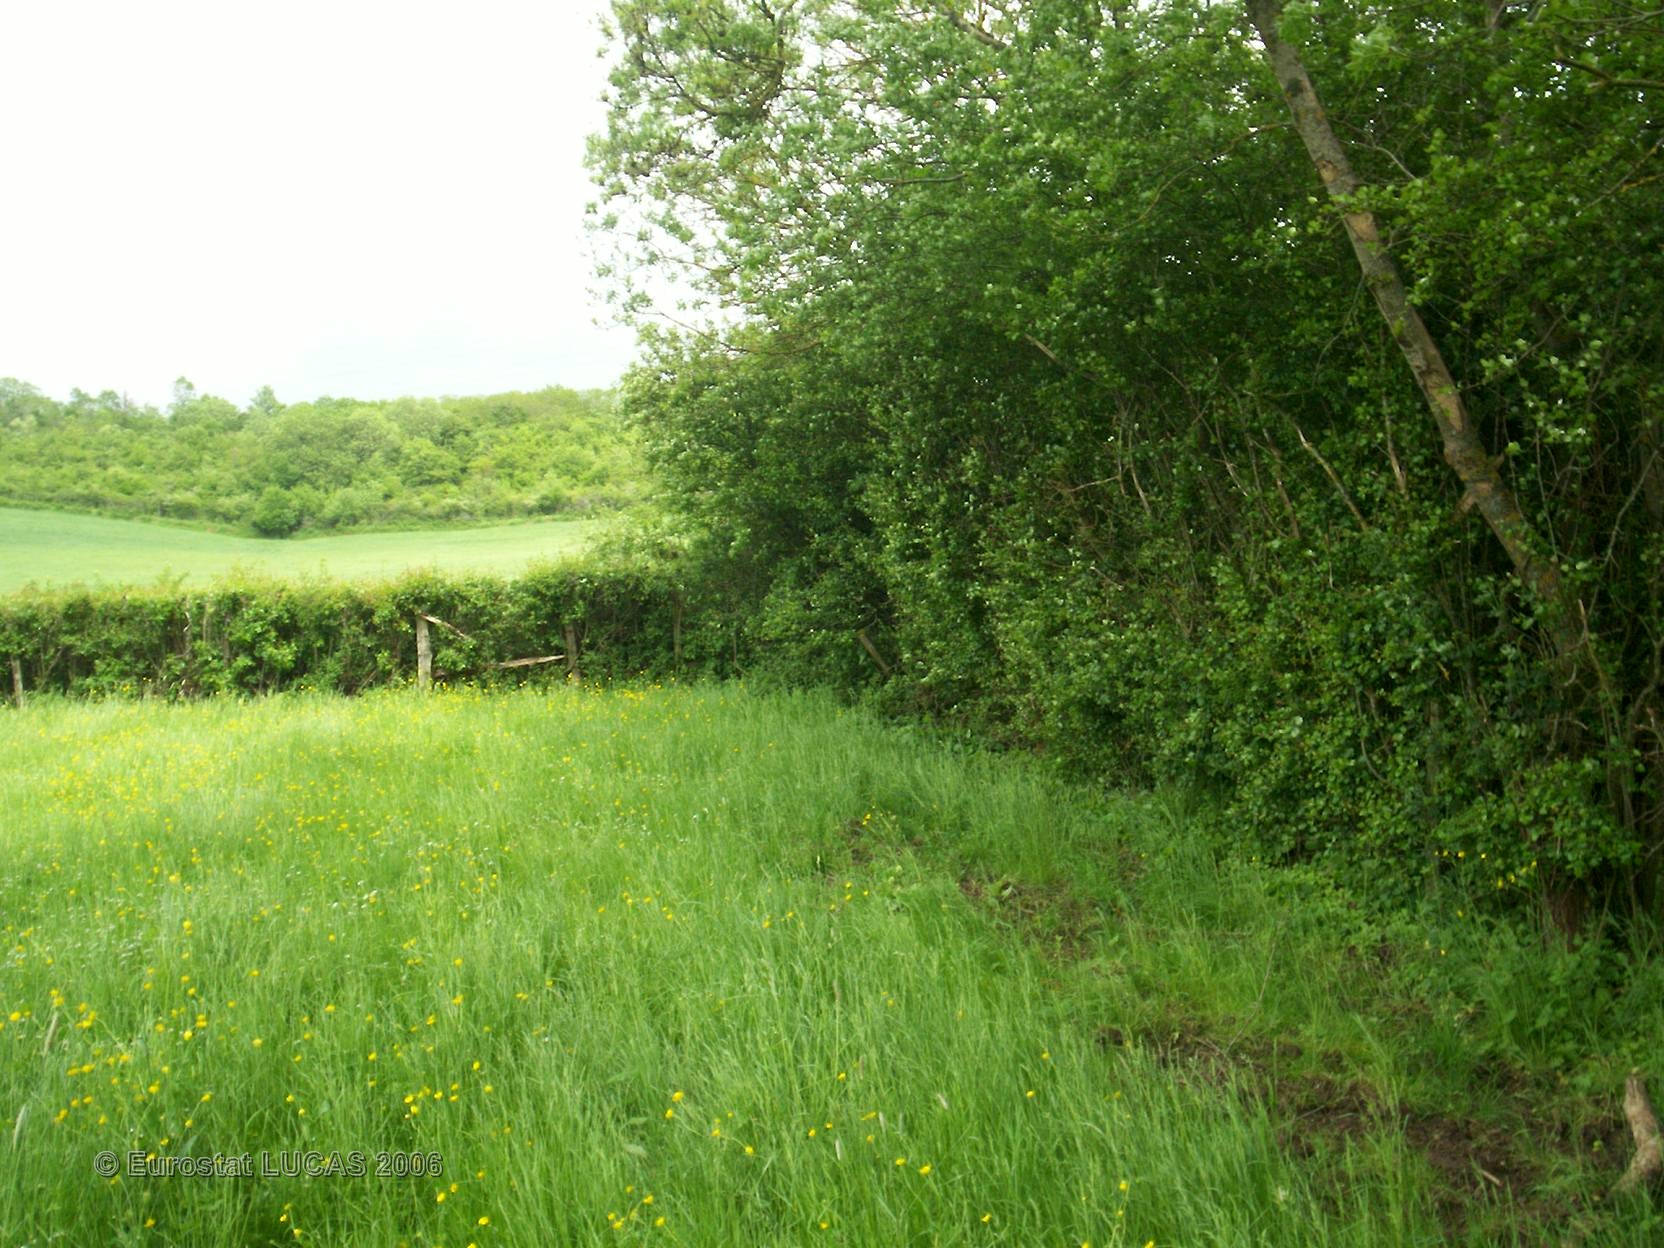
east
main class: Grassland
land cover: Grassland without tree/shrub cover
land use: Agriculture (excluding fallow land and kitchen gardens)
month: May
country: FR
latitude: 47.1189
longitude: 4.6358
